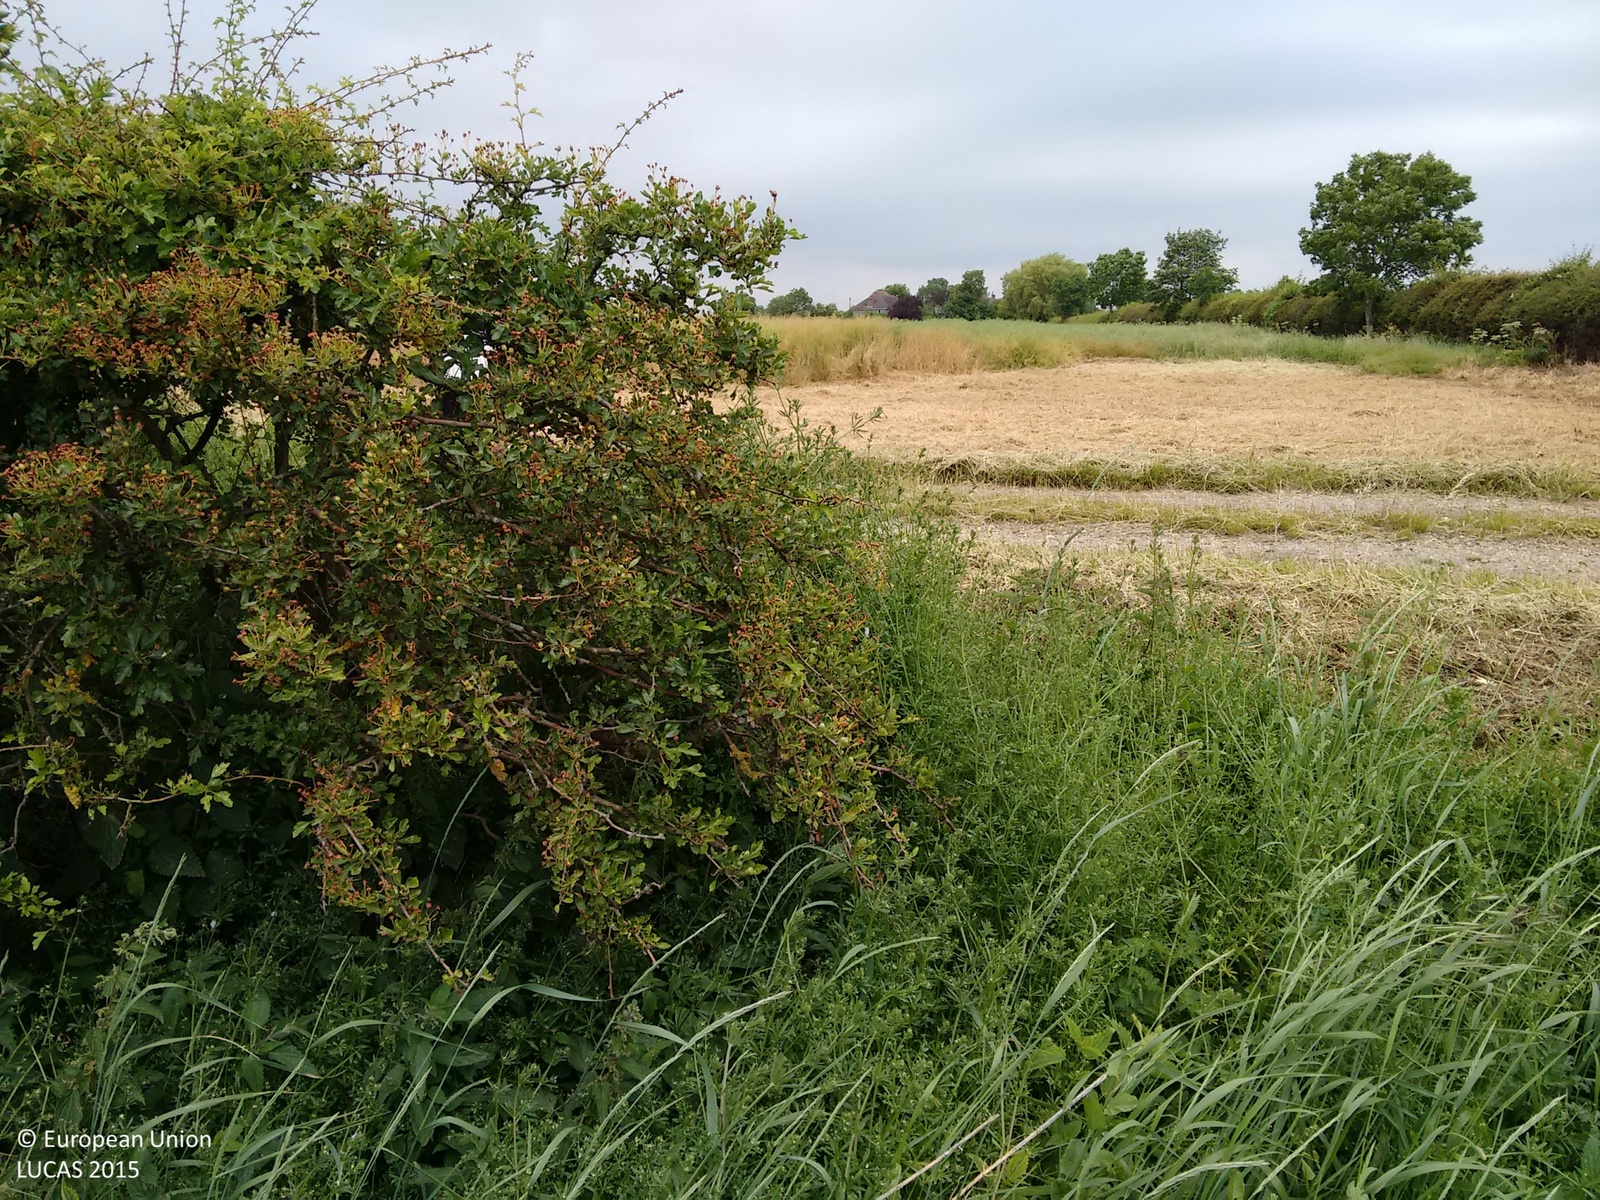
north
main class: Cropland
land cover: Barley
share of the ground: > 75 %
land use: Agriculture (excluding fallow land and kitchen gardens)
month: June
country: GB
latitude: 52.9481
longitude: -0.8619
